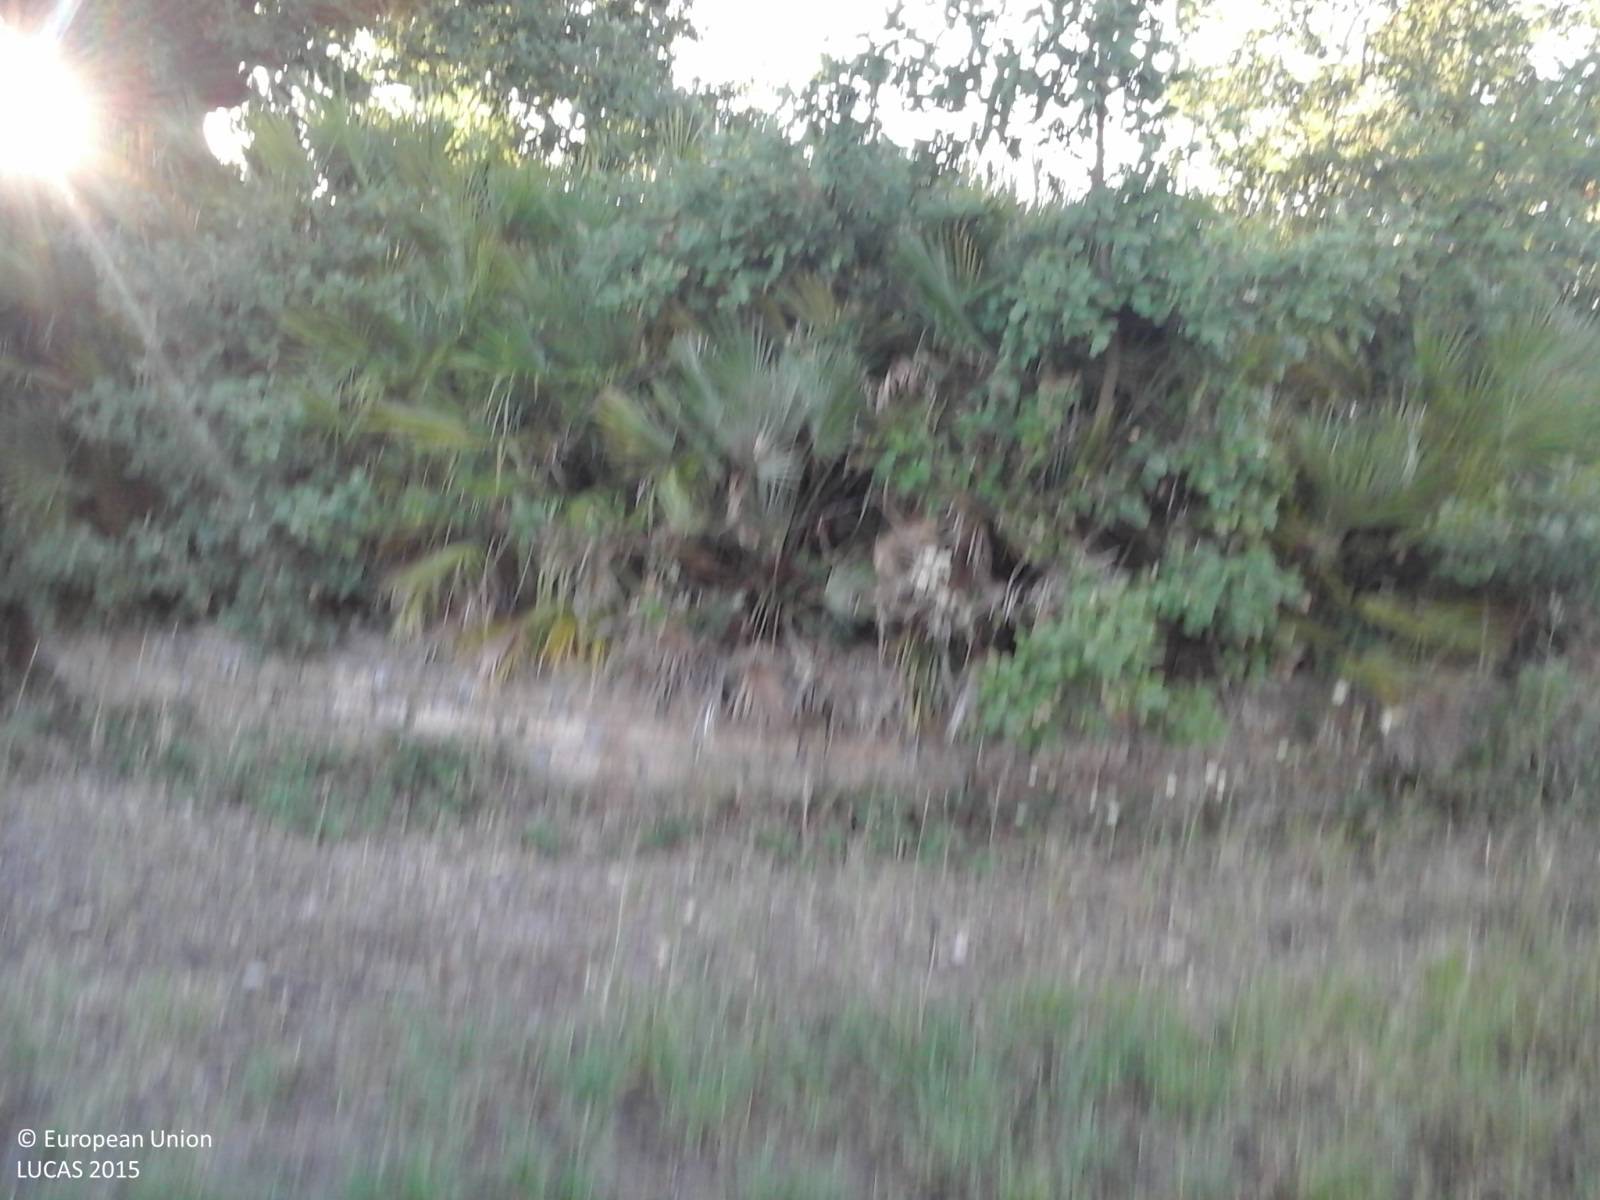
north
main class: Grassland
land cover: Grassland without tree/shrub cover
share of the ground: > 75 %
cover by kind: herbaceous plants 100 %
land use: Agriculture (excluding fallow land and kitchen gardens)
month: July
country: IT
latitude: 42.0660
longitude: 12.3722
